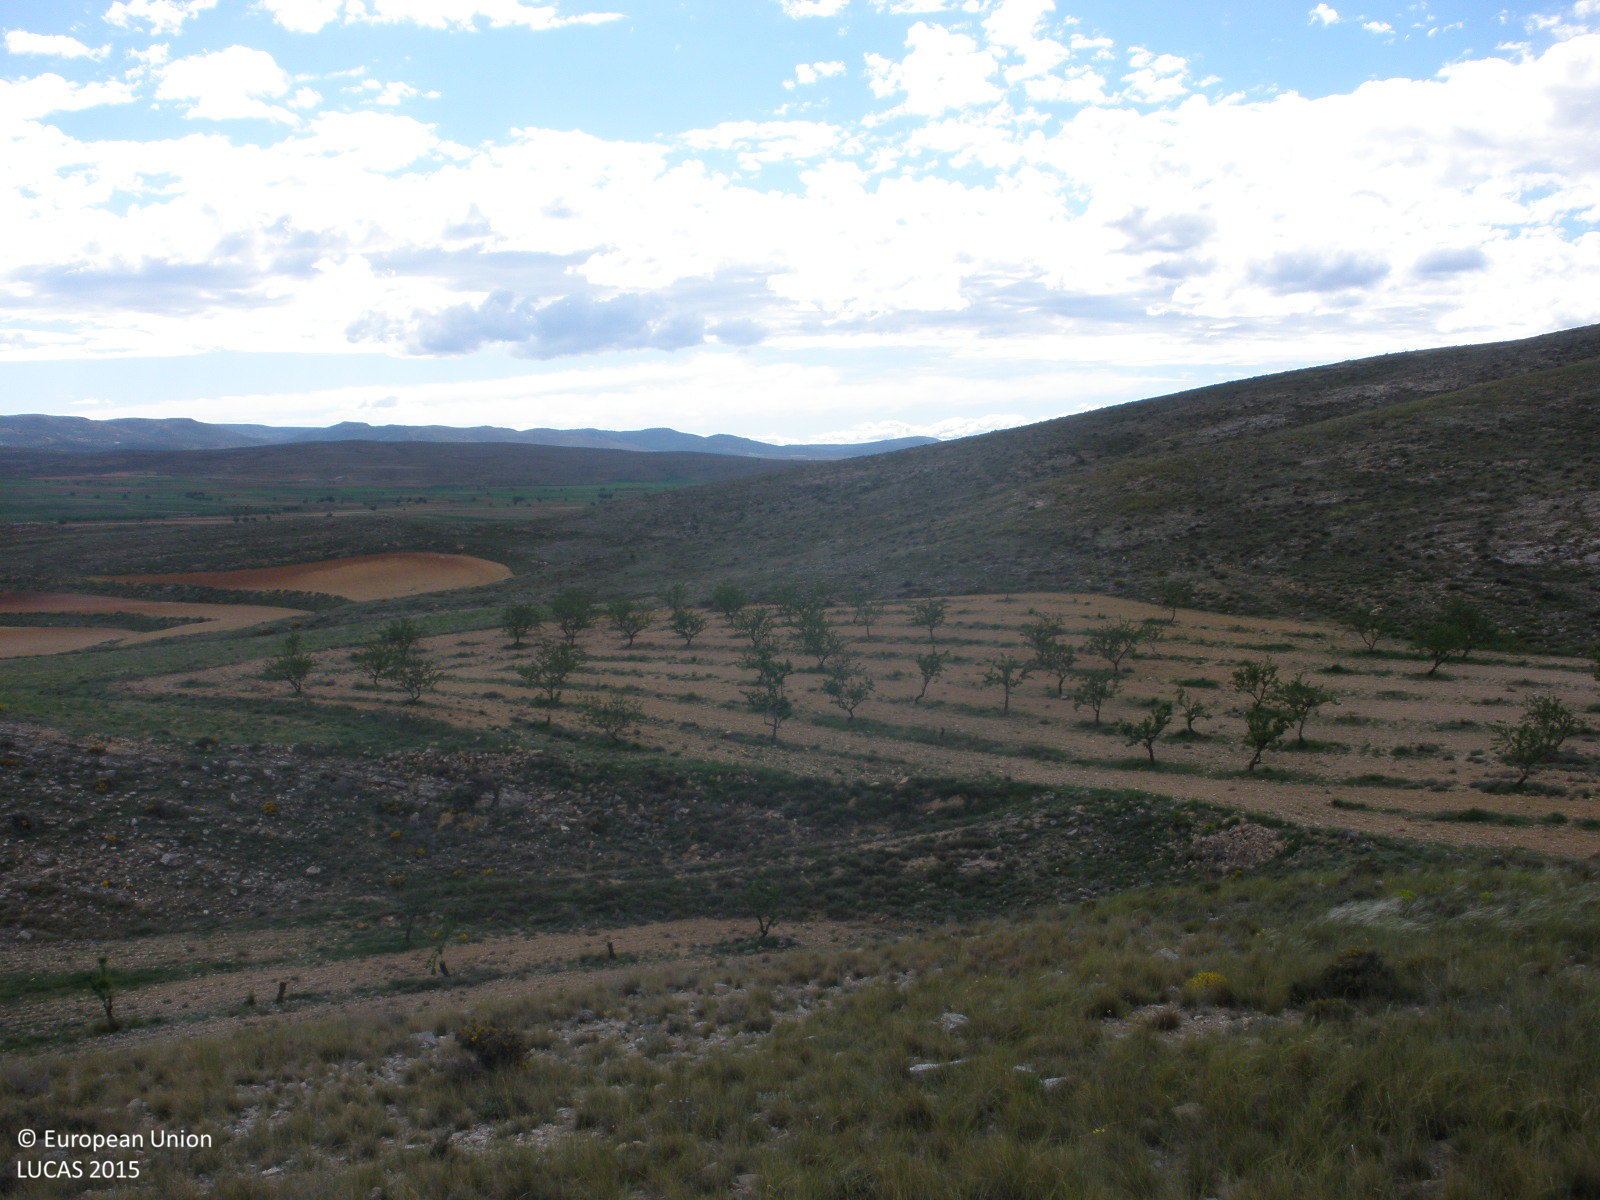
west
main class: Shrubland
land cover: Shrubland without tree cover
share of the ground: 25 - 50 %
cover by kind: herbaceous plants 40 %, shrubs 30 %, consolidated bare surface 30 %
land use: Agriculture (excluding fallow land and kitchen gardens)
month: May
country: ES
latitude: 41.0438
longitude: -0.9014
